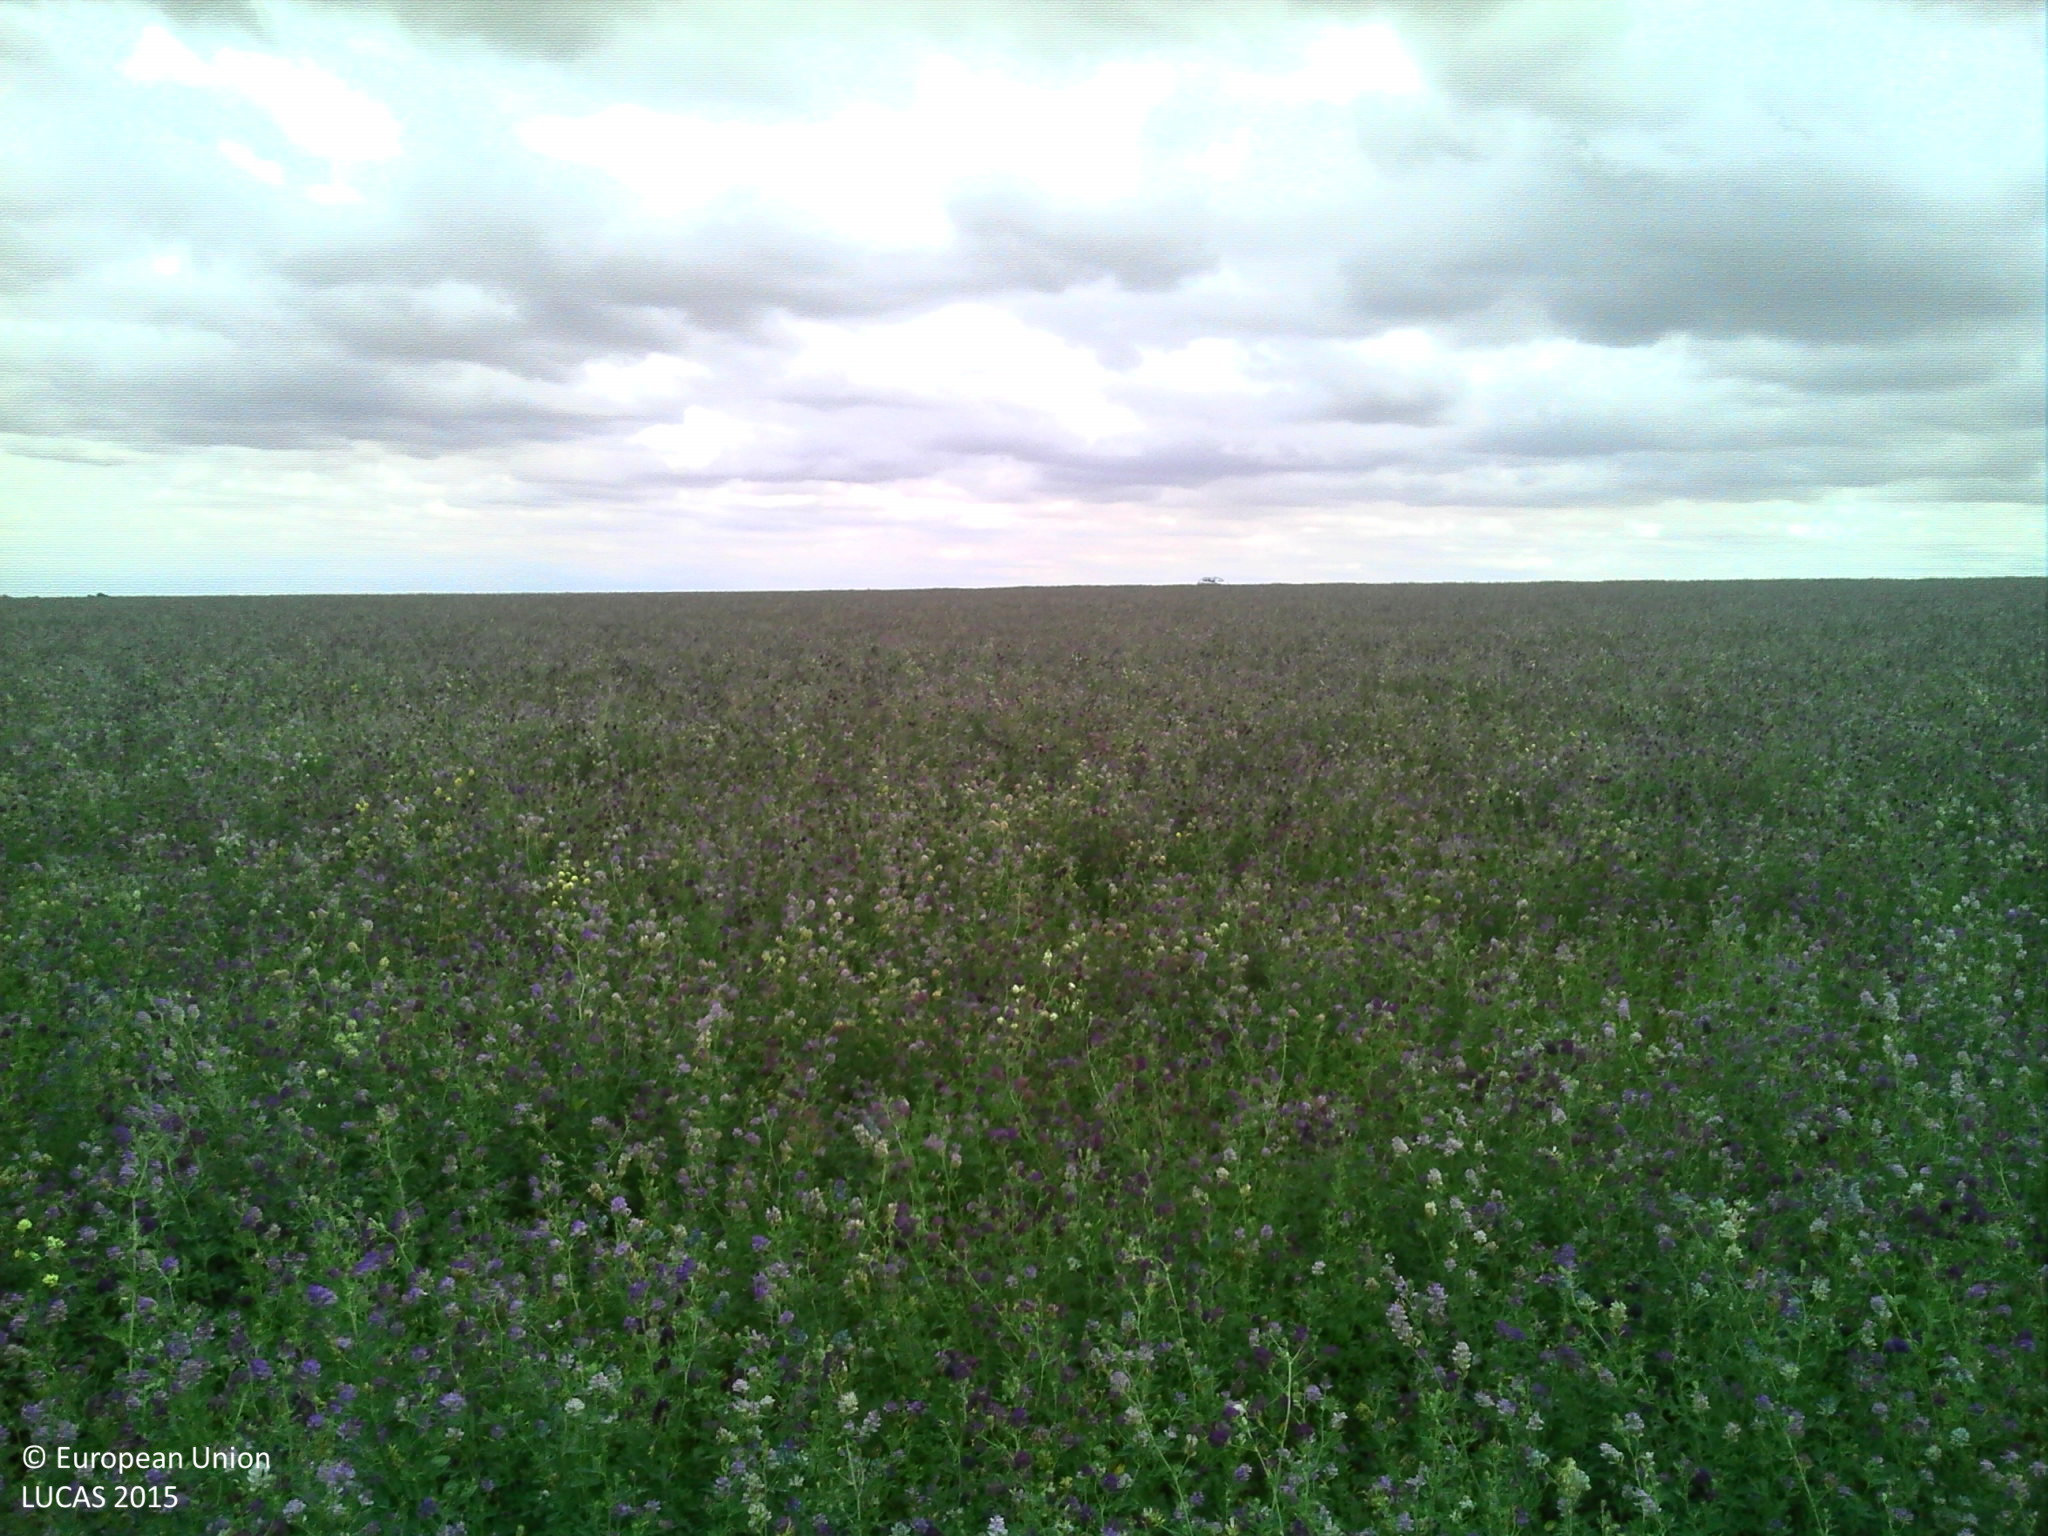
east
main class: Cropland
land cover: Lucerne
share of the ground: > 75 %
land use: Agriculture (excluding fallow land and kitchen gardens)
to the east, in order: Lucerne; Grass margins; Tracks; Grass margins; Common wheat
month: July
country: FR
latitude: 48.8109
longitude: 4.2087
